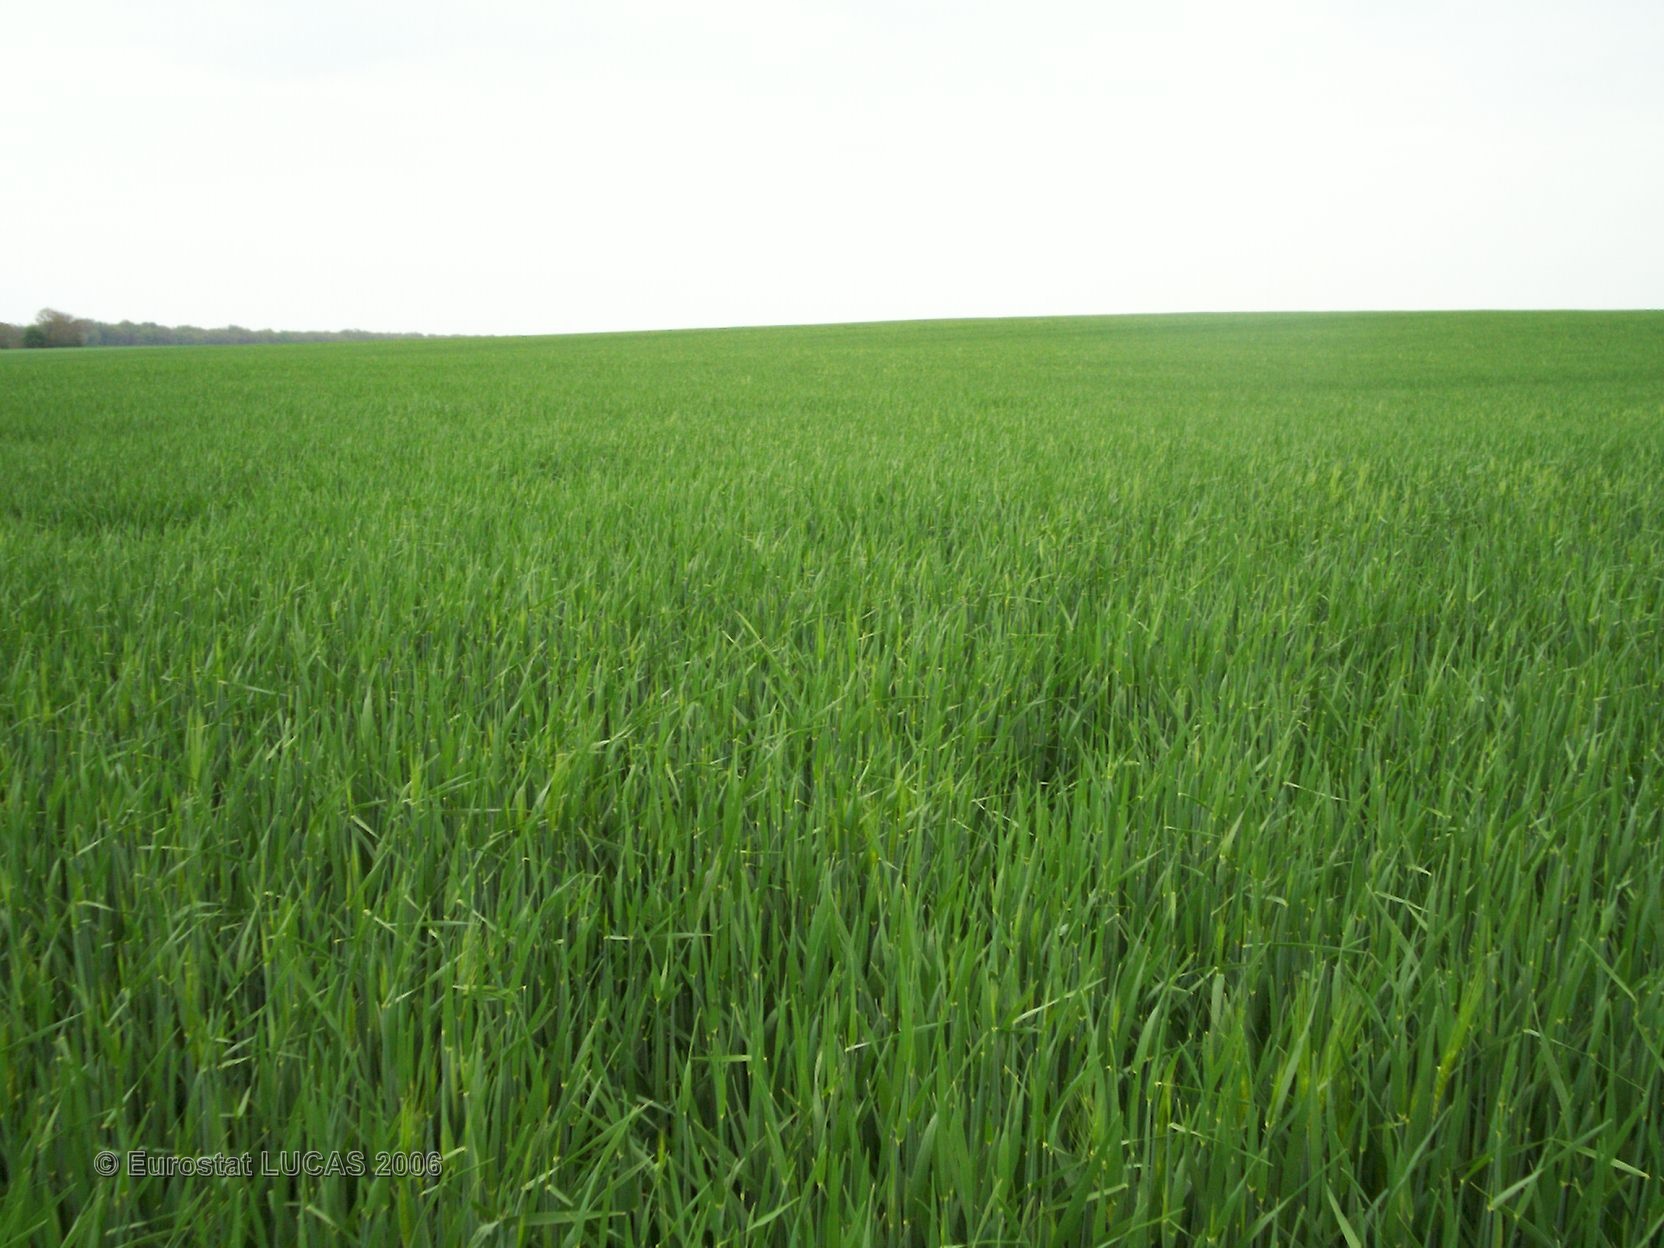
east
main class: Cropland
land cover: Barley
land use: Agriculture (excluding fallow land and kitchen gardens)
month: April
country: FR
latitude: 46.9032
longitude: 1.5475
